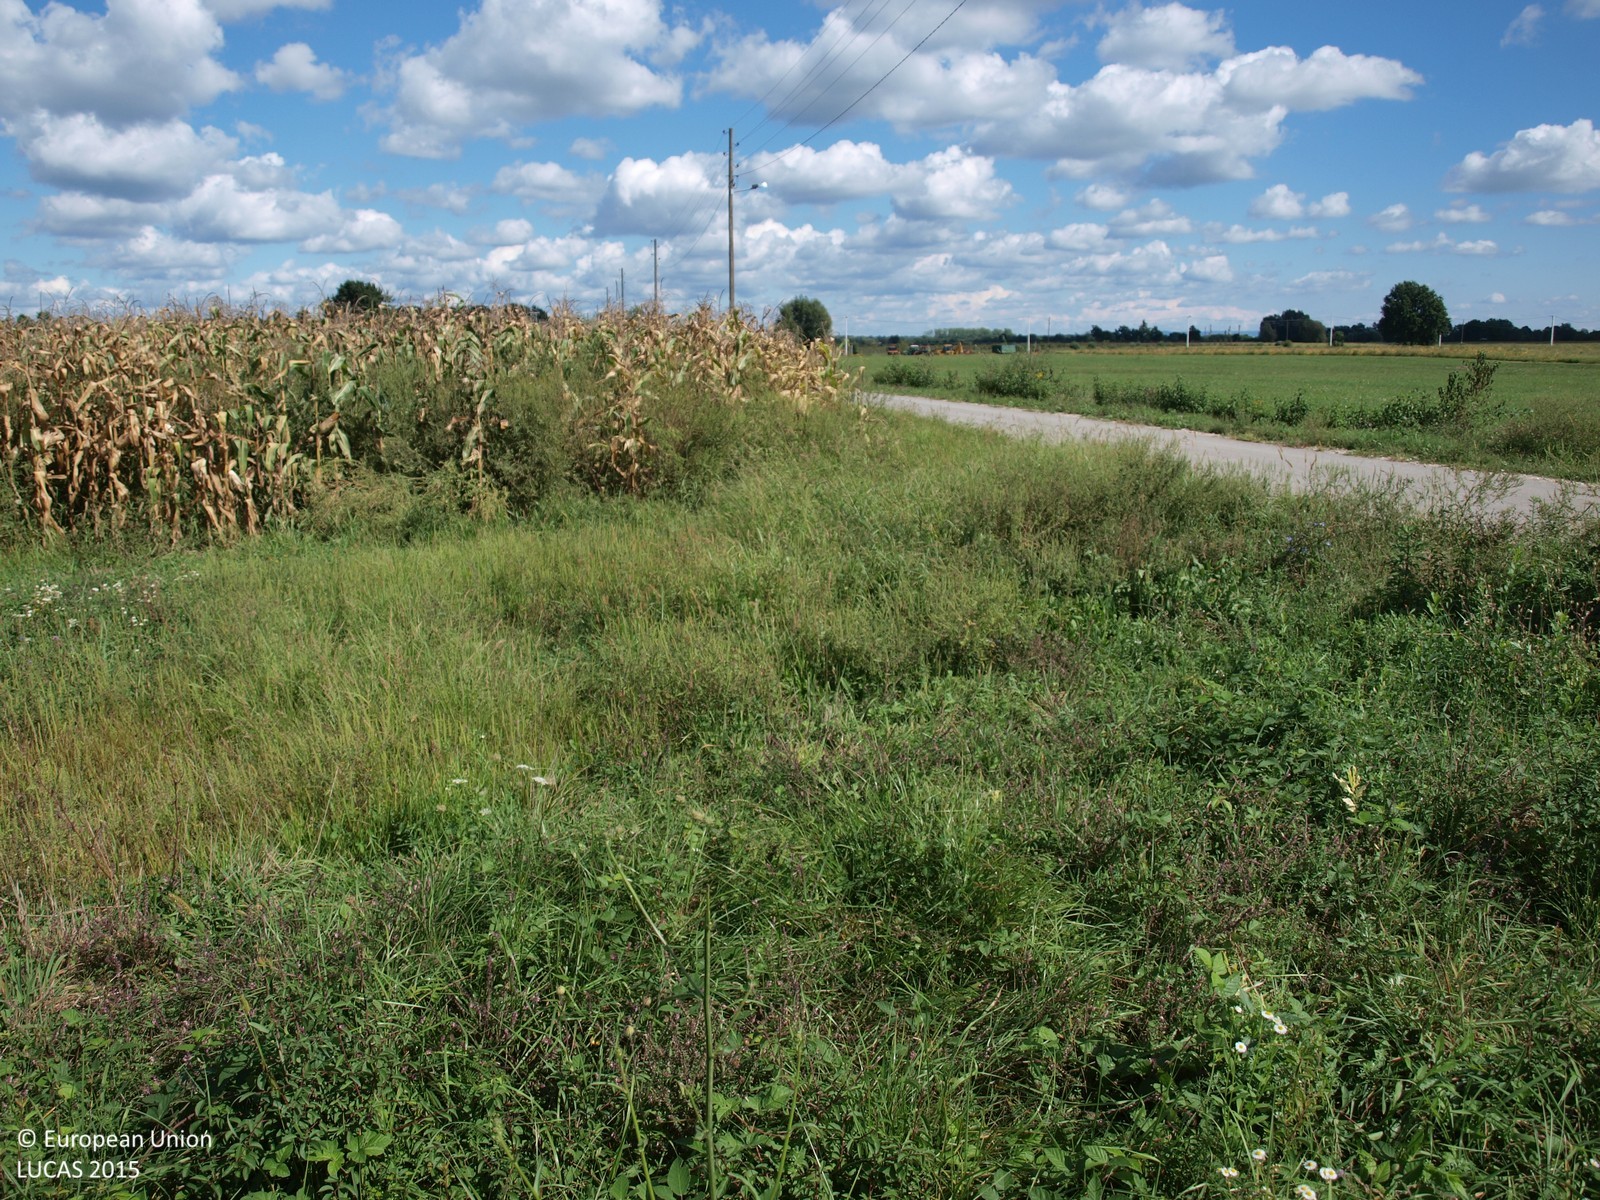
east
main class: Grassland
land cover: Grassland without tree/shrub cover
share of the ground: > 75 %
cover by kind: herbaceous plants 100 %
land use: Semi-natural and natural areas not in use
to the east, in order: Grassland without tree/shrub cover; Maize; Electric lines; Paved roads, cycling and walking lanes; Grassland without tree/shrub cover; Artificial constructions in urban areas
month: September
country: HR
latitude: 45.7283
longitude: 16.3591
